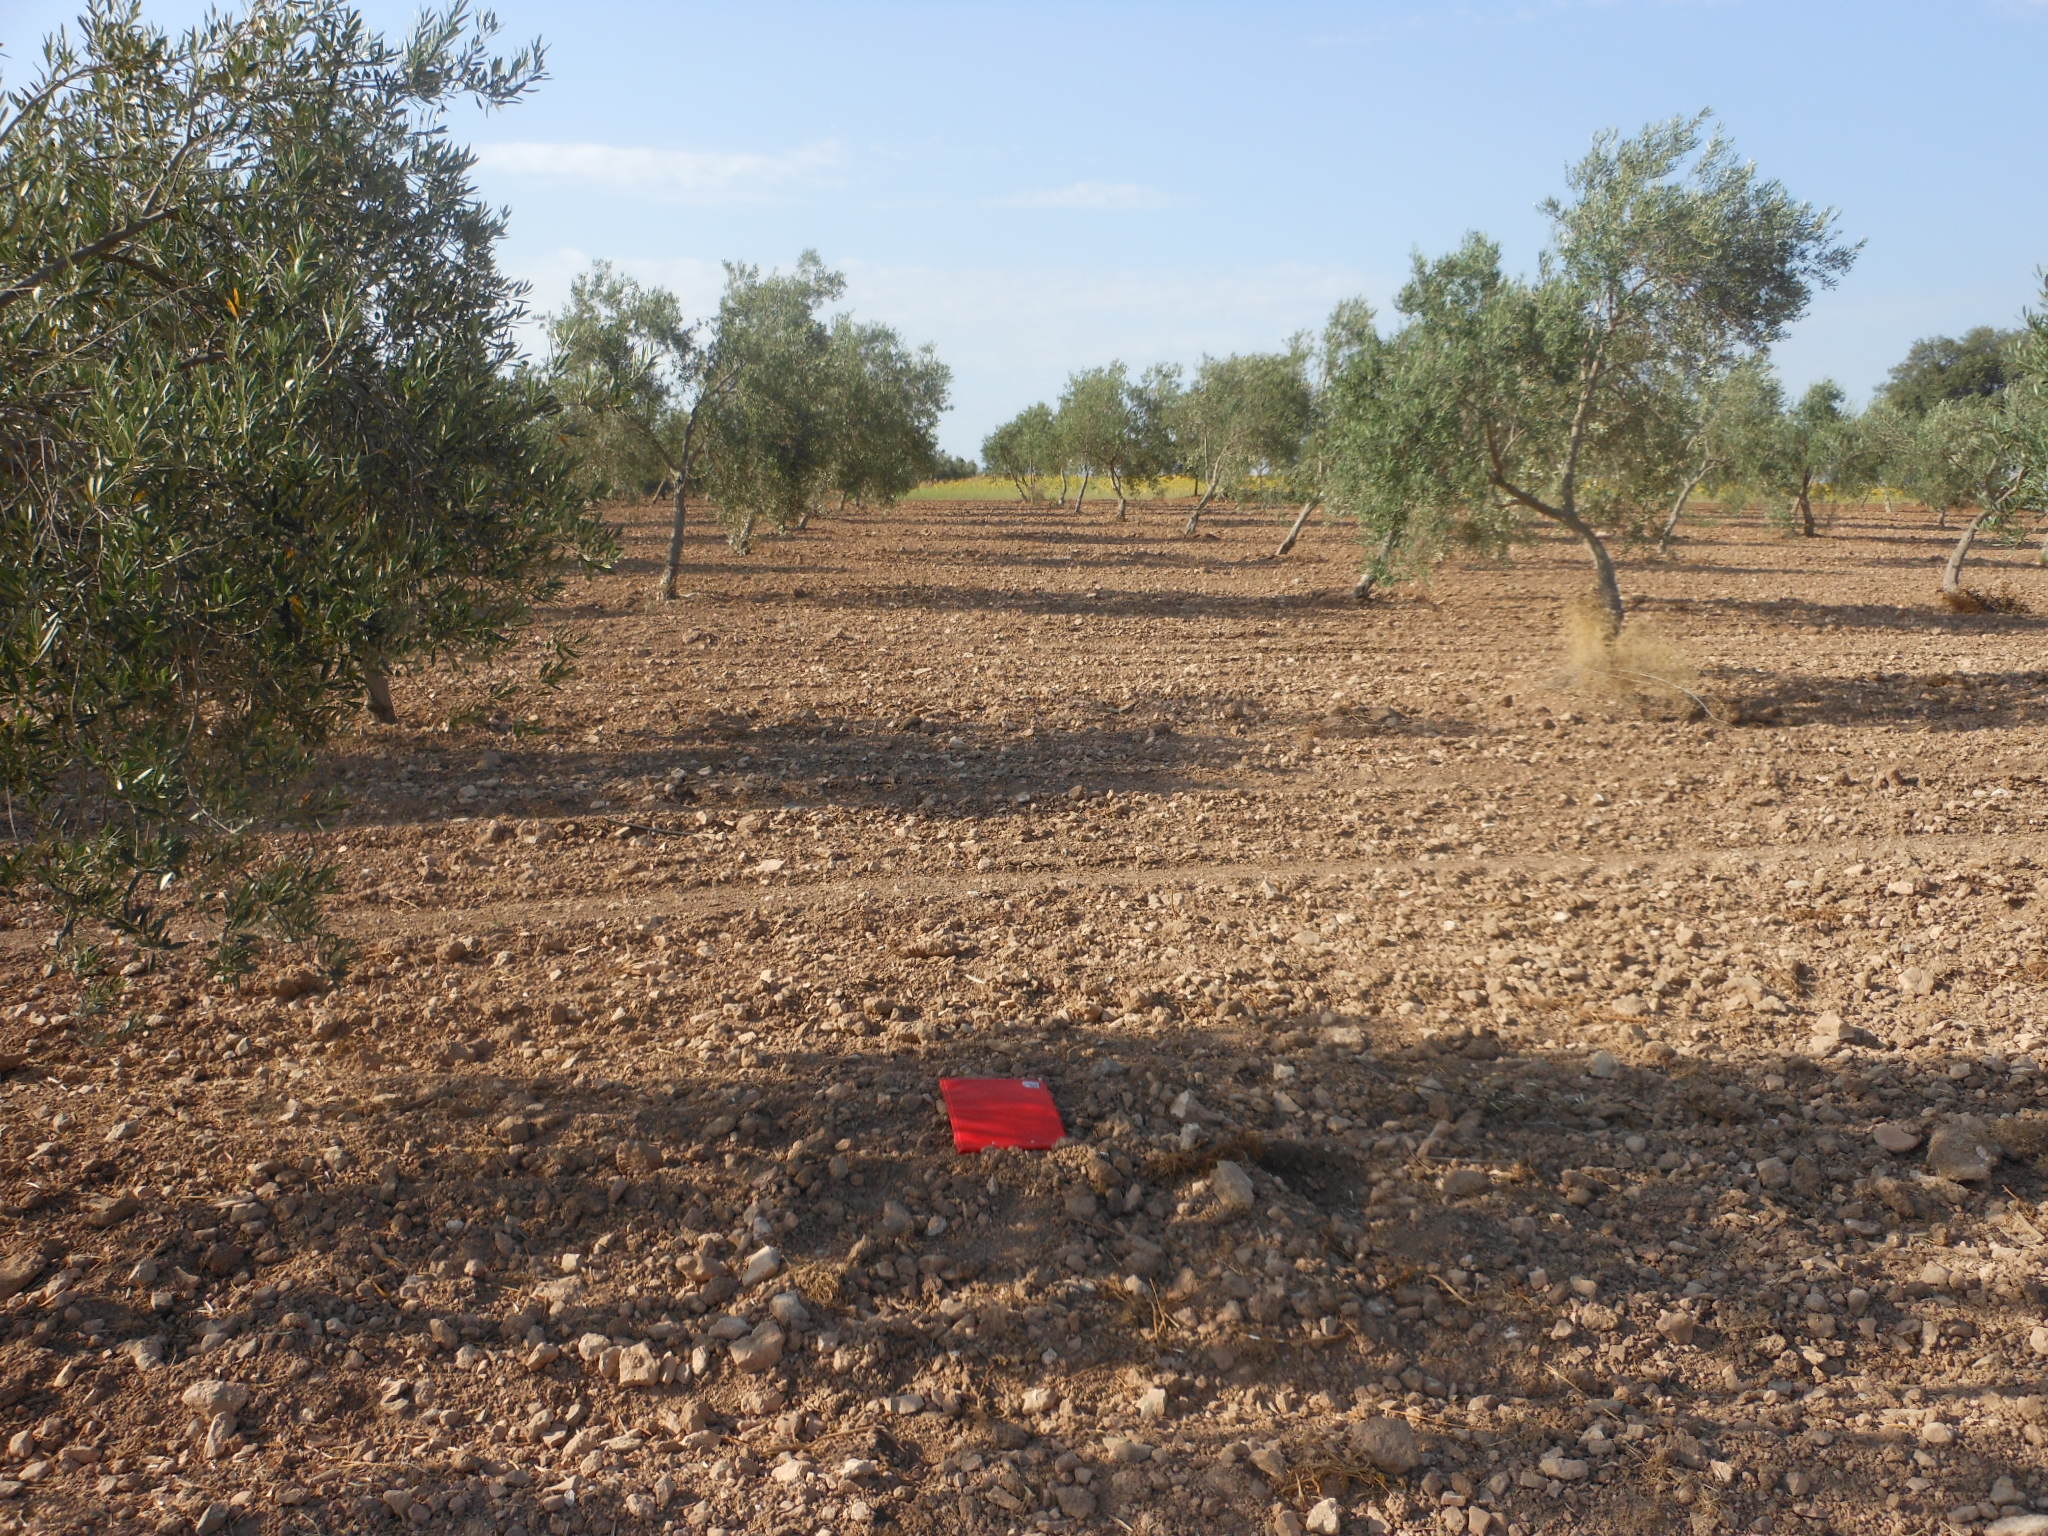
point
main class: Cropland
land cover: Olive groves
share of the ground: 10 - 25 %
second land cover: Other bare soil
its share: > 75 %
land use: Agriculture (excluding fallow land and kitchen gardens)
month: June
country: ES
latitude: 37.2871
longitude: -5.1119
